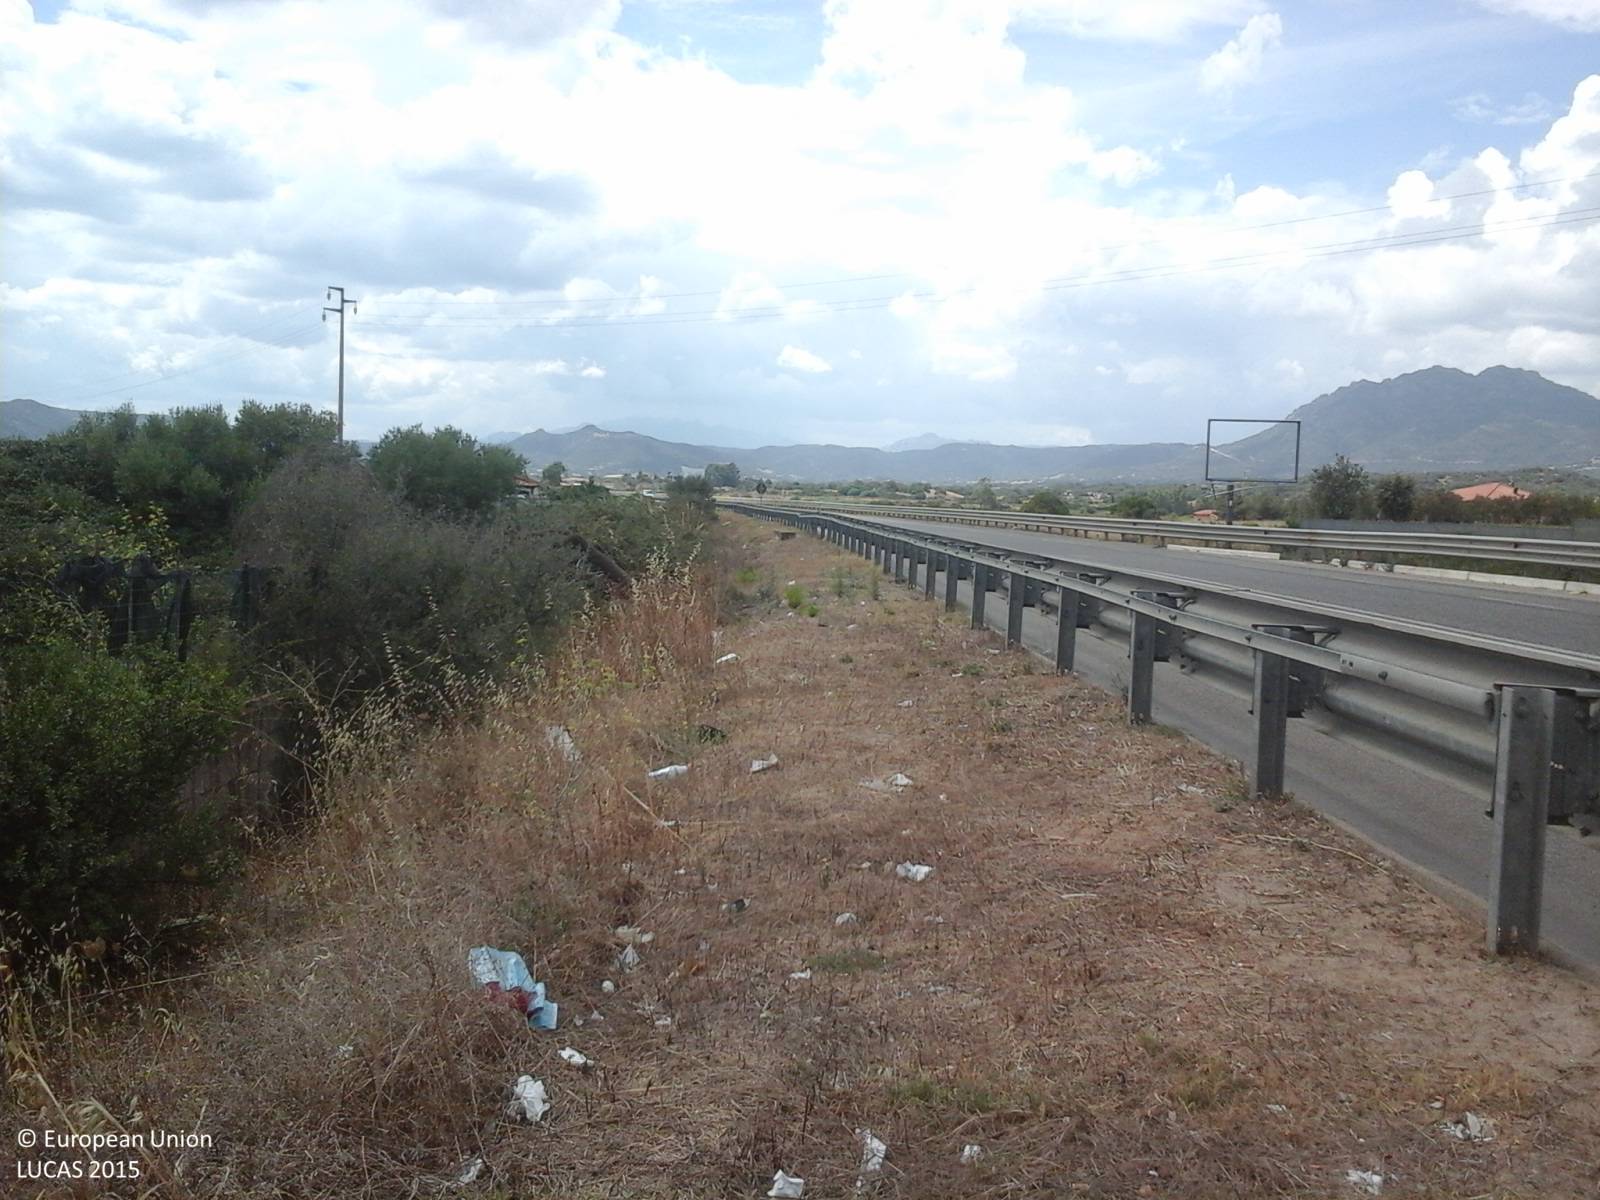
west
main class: Grassland
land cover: Grassland without tree/shrub cover
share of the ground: > 75 %
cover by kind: herbaceous plants 90 %, unconsolidated bare surface 10 %
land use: Agriculture (excluding fallow land and kitchen gardens)
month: August
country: IT
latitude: 40.9355
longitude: 9.4680
